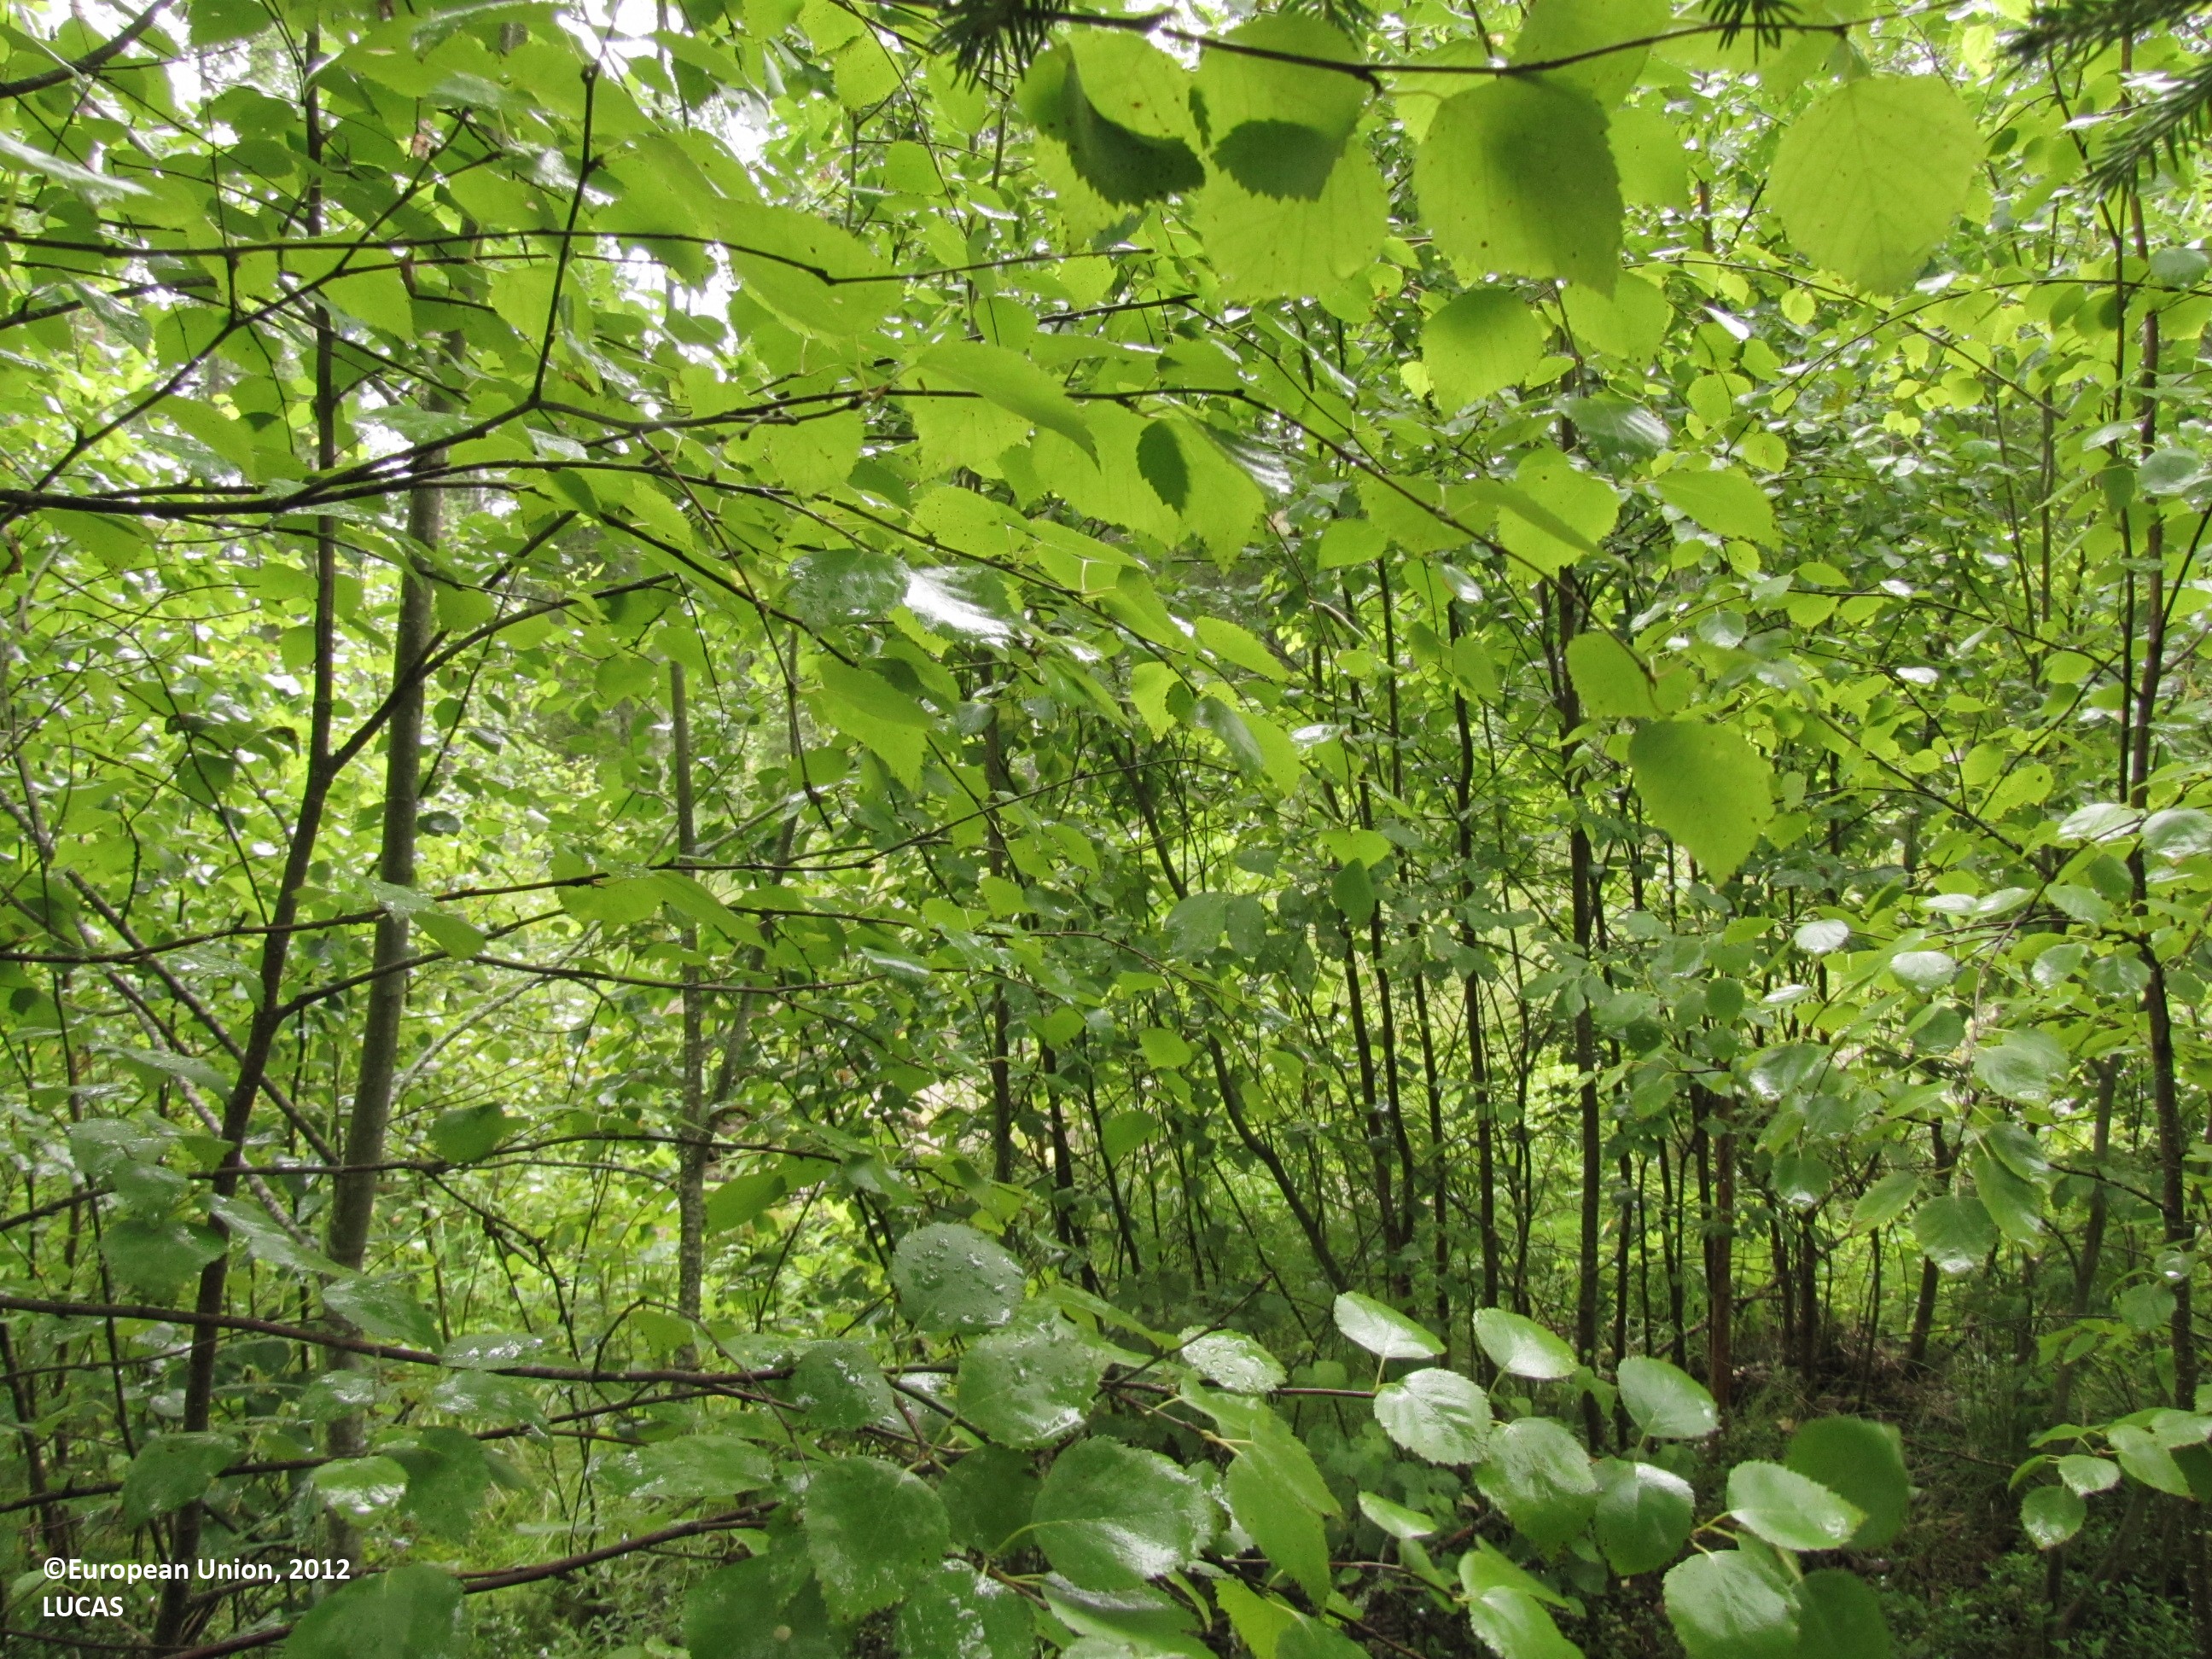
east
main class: Woodland
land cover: Other mixed woodland
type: boreal forest
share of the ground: > 75 %
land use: Forestry
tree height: > 5 m
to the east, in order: Other mixed woodland; Grassland without tree/shrub cover; Grass margins; Ditches and canals; Spruce dominated mixed woodland; Ditches and canals; Pine dominated mixed woodland; Ditches and canals; Pine dominated mixed woodland; Ditches and canals; Pine dominated mixed woodland; Ditches and canals; Pine dominated mixed woodland
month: July
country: FI
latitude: 62.5977
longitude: 22.9746
